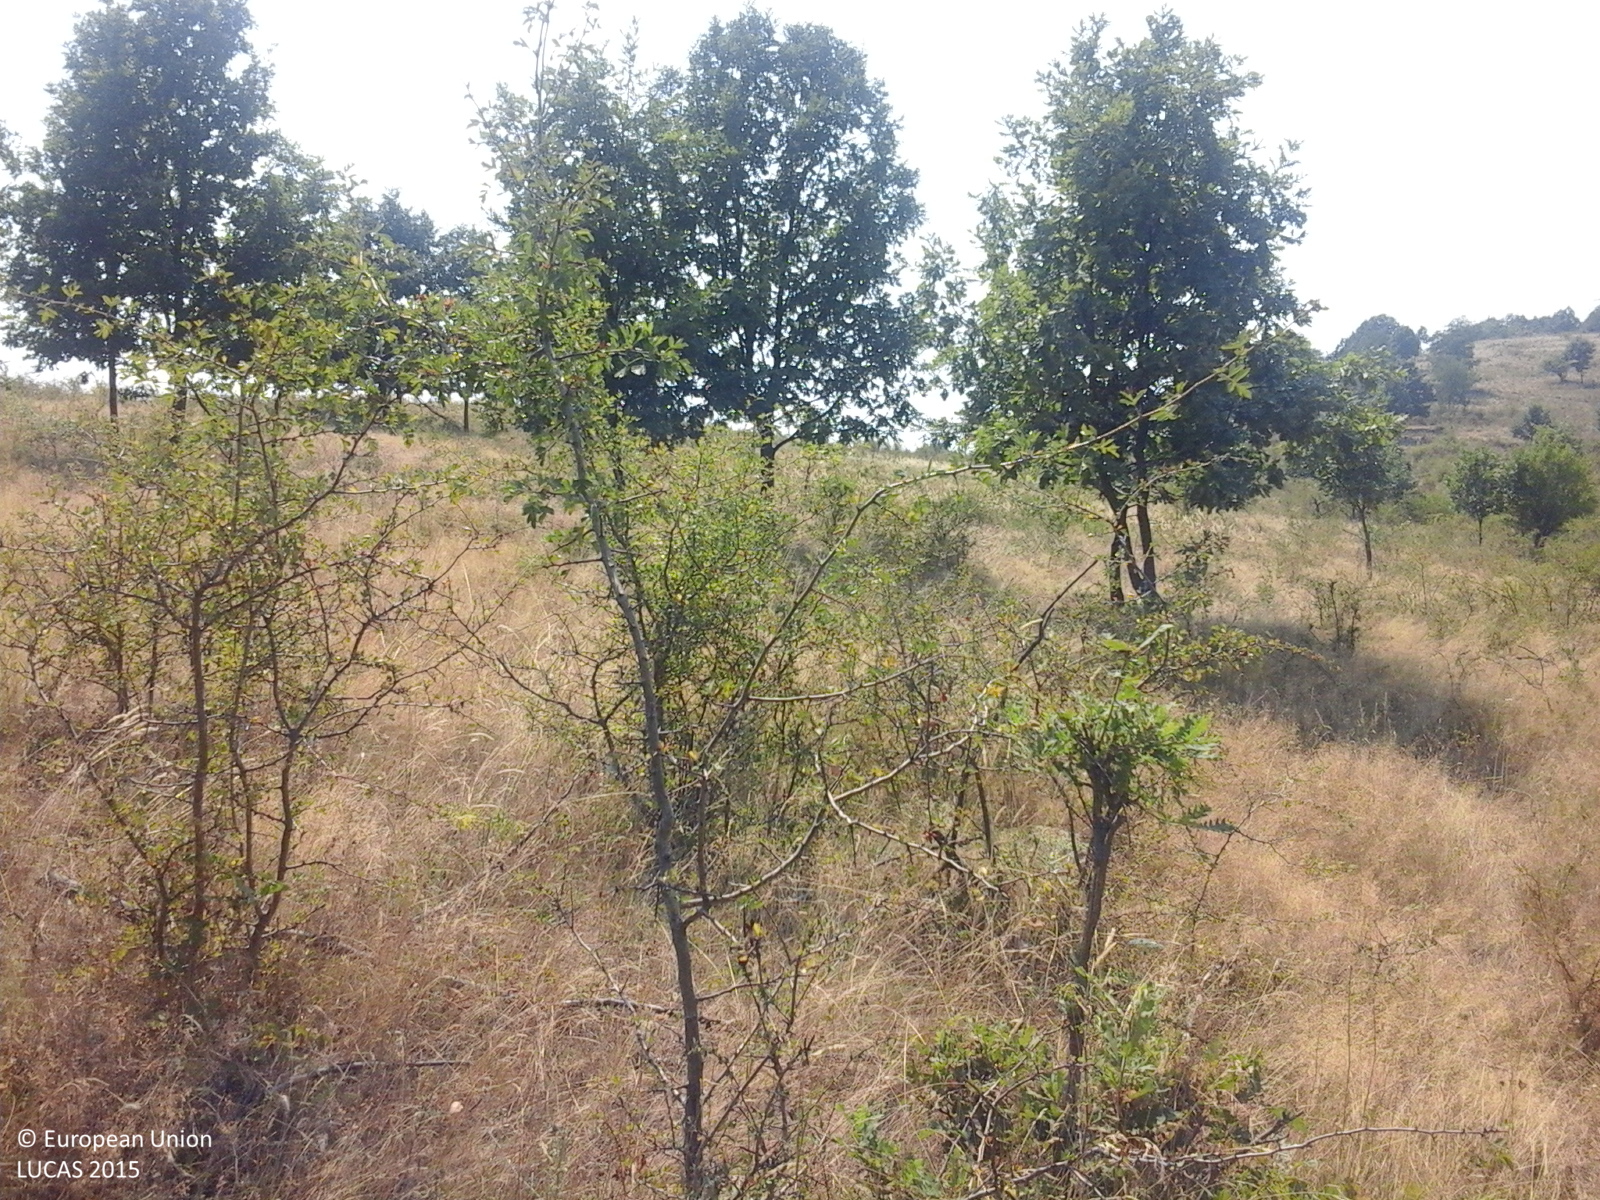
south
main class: Grassland
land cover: Grassland with sparse tree/shrub cover
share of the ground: > 75 %
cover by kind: herbaceous plants 85 %, shrubs 10 %, broadleaved forest trees 5 %
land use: Agriculture (excluding fallow land and kitchen gardens)
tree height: > 5 m
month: August
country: RO
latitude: 44.6009
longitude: 23.0361
